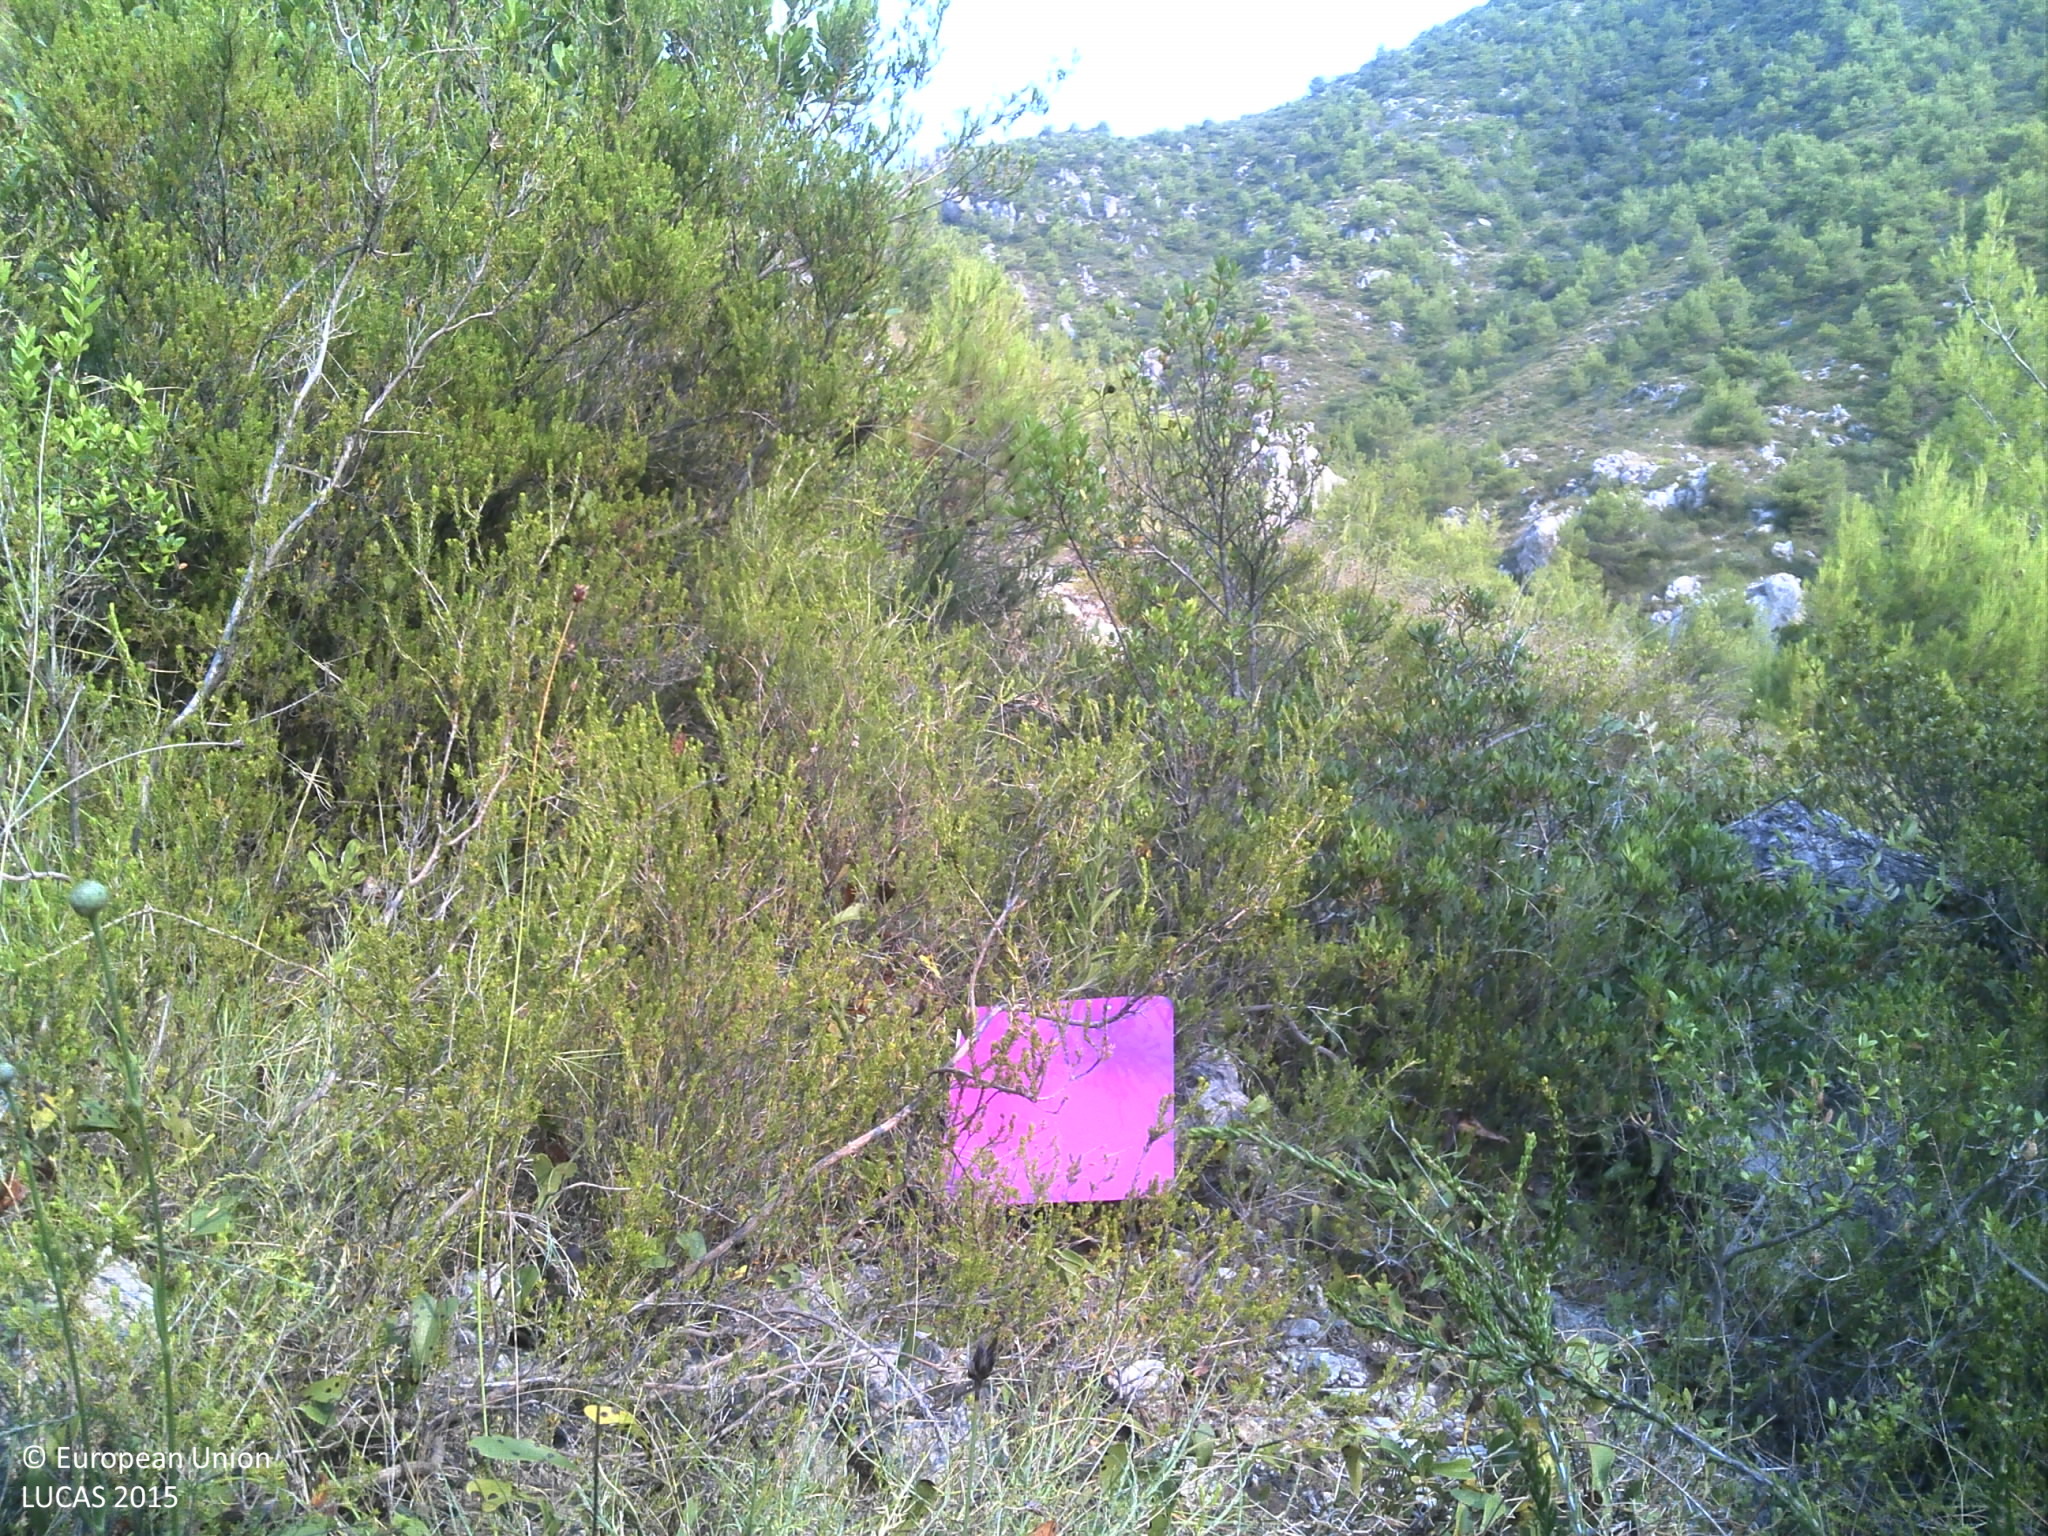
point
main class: Woodland
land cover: Pine dominated coniferous woodland
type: coniferous forest of the mediterranean region
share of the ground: > 75 %
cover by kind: coniferous forest trees 60 %, shrubs 20 %, consolidated bare surface 10 %, unconsolidated bare surface 10 %
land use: Semi-natural and natural areas not in use
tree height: > 5 m
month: July
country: HR
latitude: 42.8134
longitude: 17.7070
